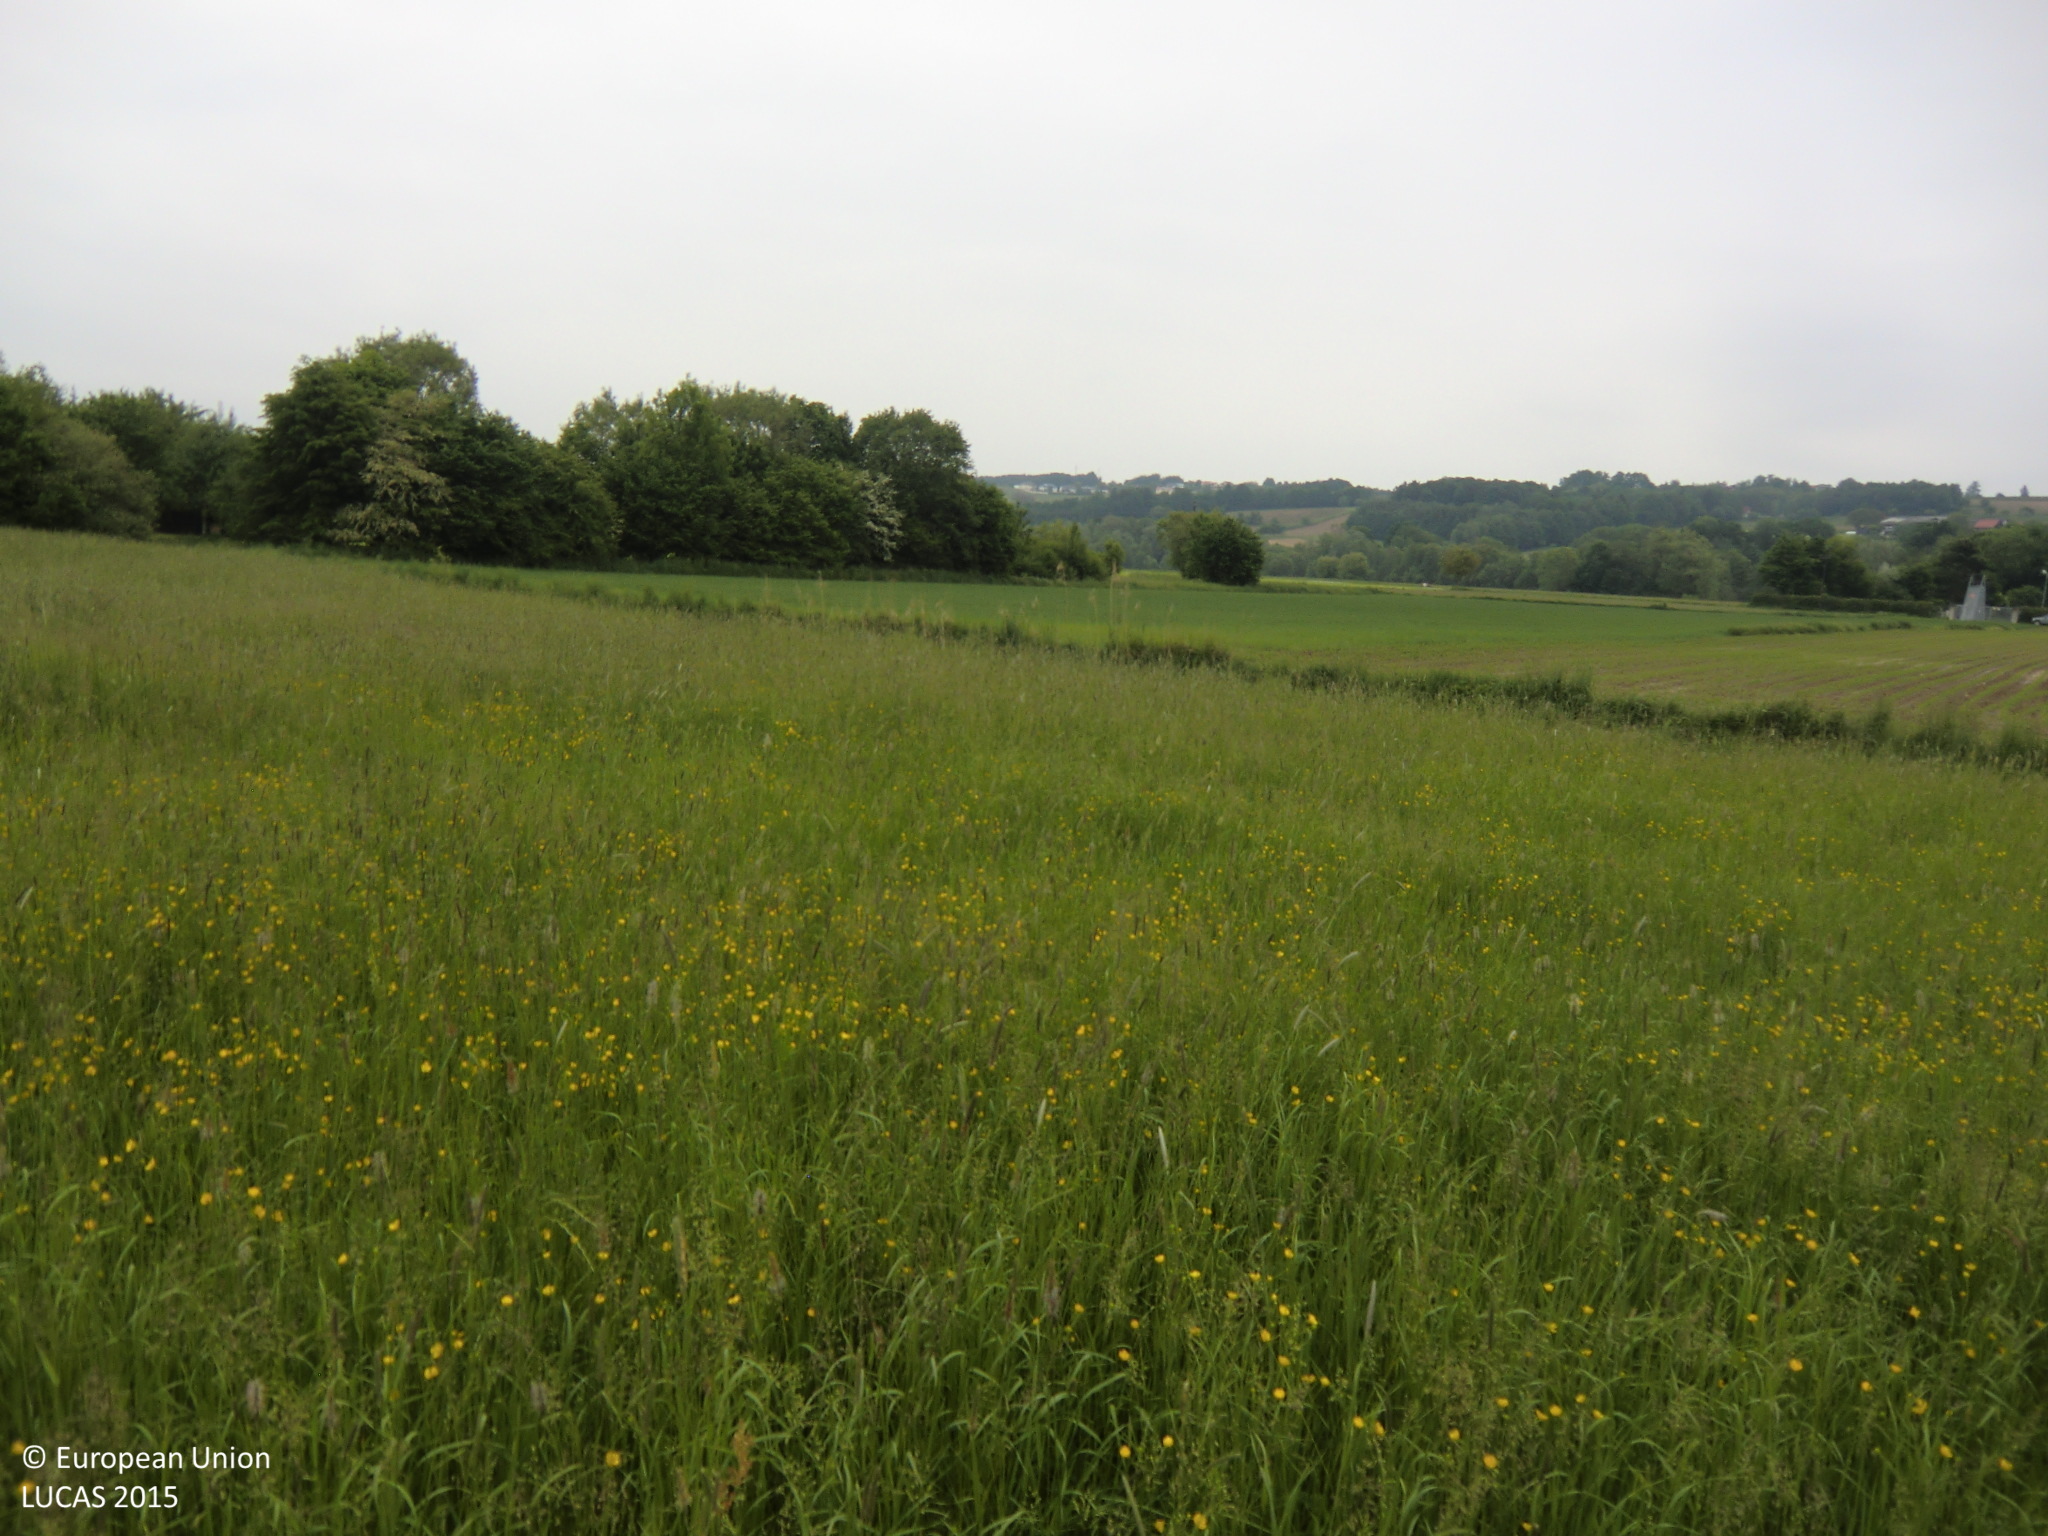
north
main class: Grassland
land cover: Grassland without tree/shrub cover
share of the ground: > 75 %
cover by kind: herbaceous plants 100 %
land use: Agriculture (excluding fallow land and kitchen gardens)
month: May
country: AT
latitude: 47.3549
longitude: 16.0256
